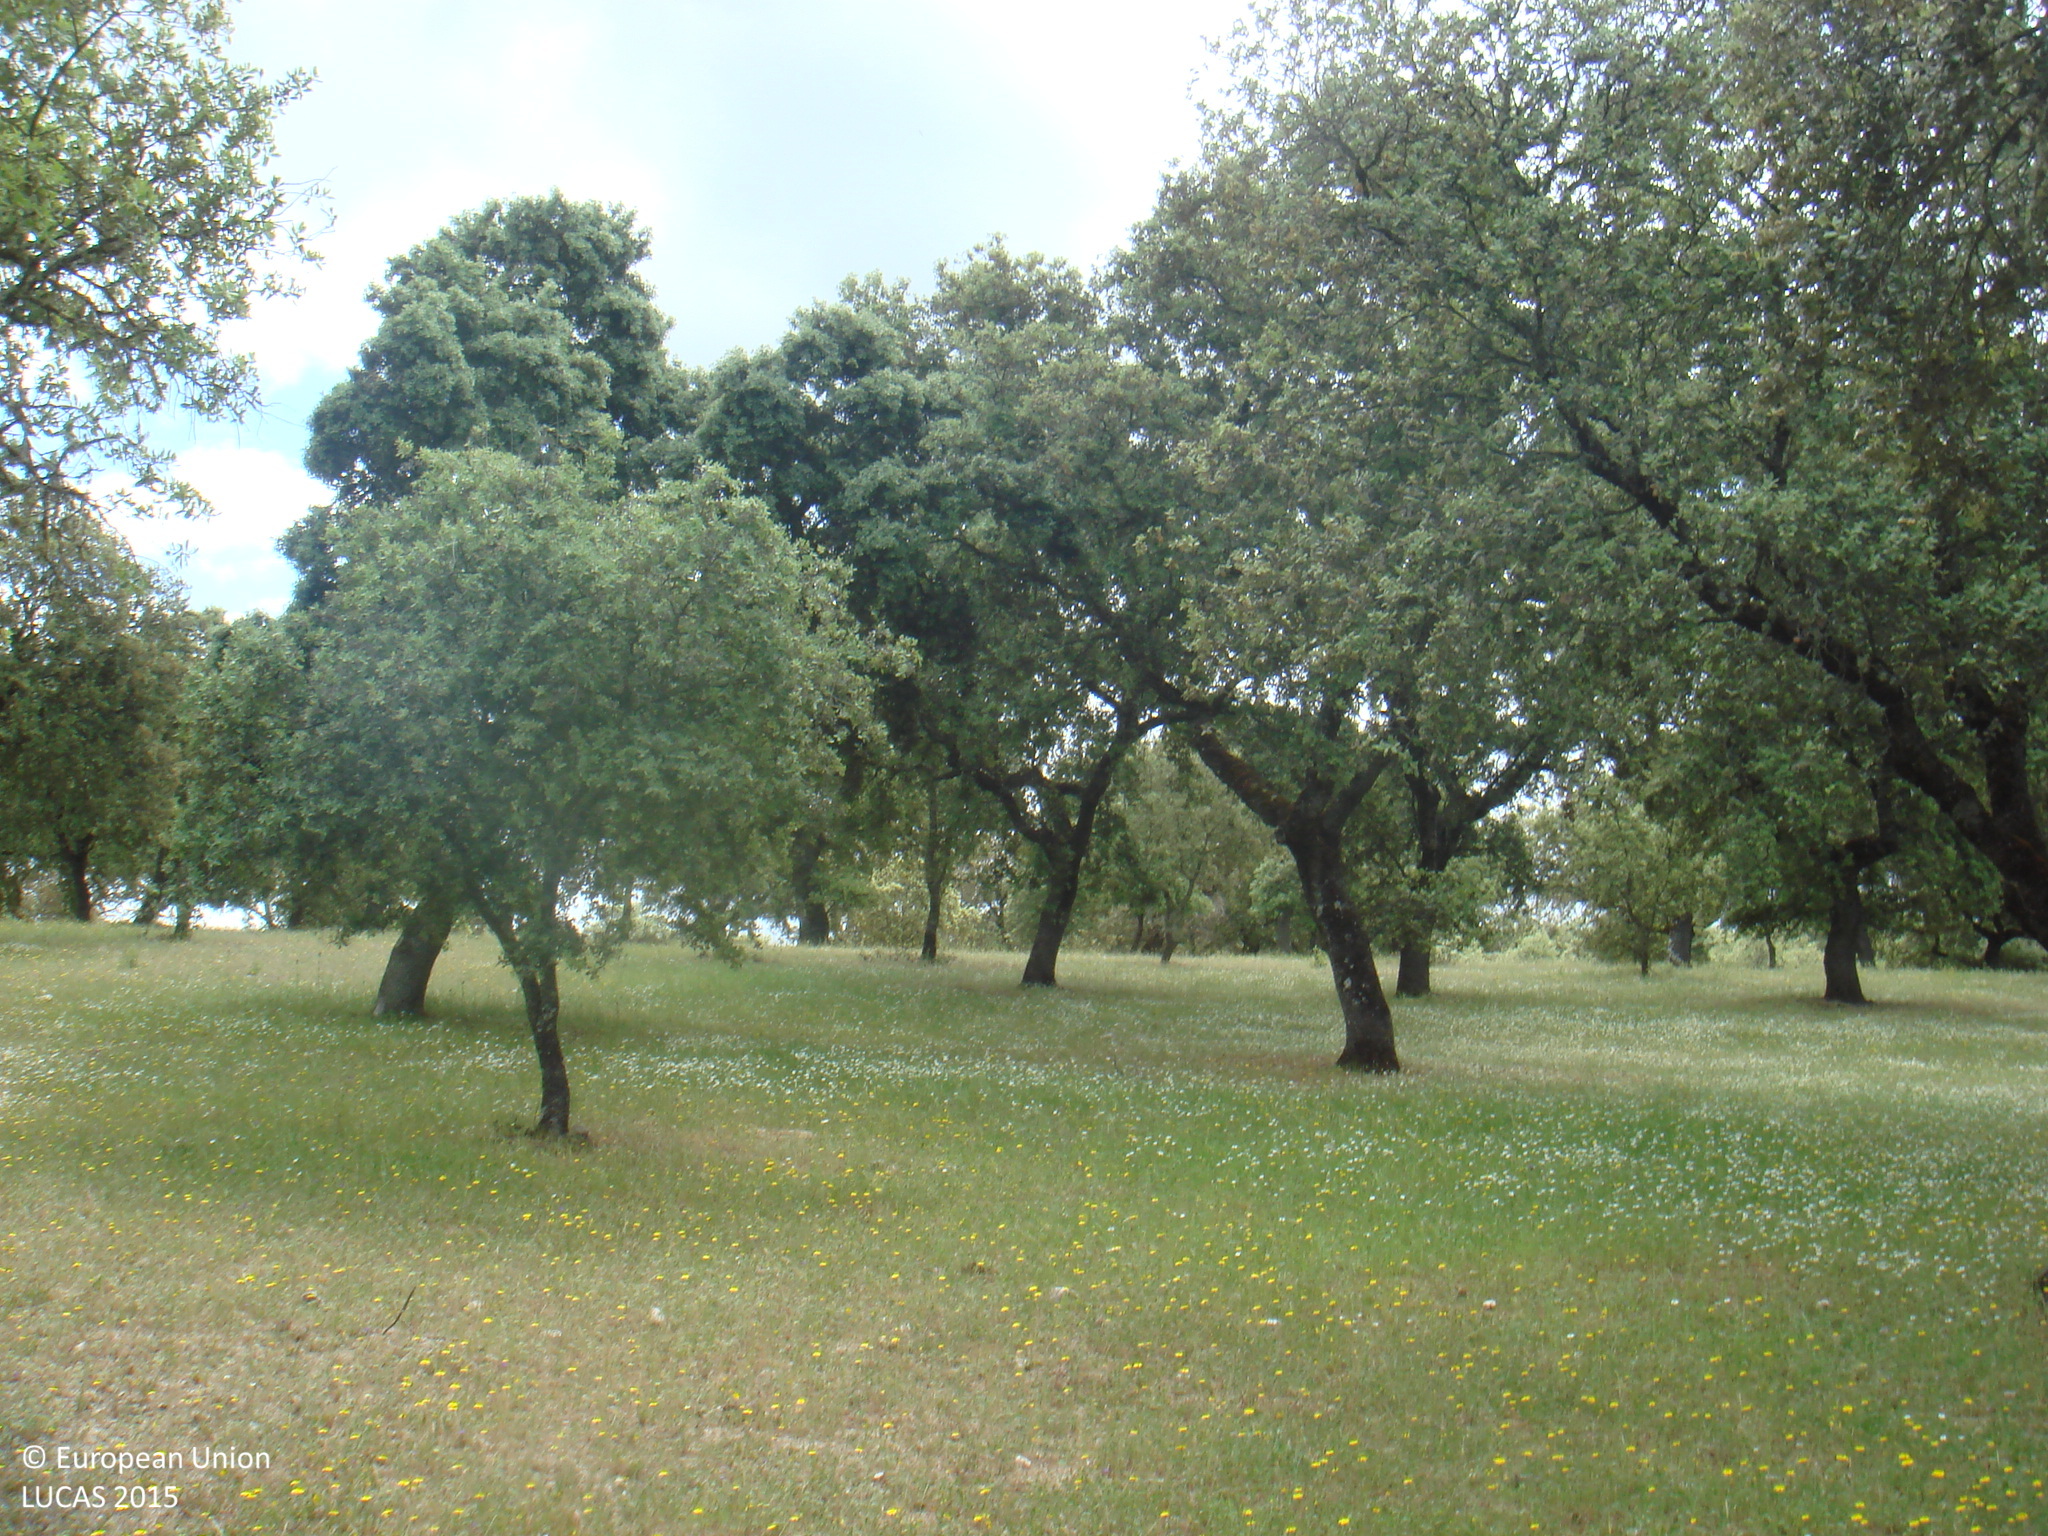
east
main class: Woodland
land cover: Broadleaved woodland
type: broadleaved evergreen forest
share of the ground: 50 - 75 %
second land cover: Spontaneously vegetated surfaces
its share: > 75 %
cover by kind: broadleaved forest trees 60 %, herbaceous plants 40 %
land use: Forestry
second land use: Agriculture (excluding fallow land and kitchen gardens)
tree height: > 5 m
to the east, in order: Broadleaved woodland; Spontaneously vegetated surfaces; Fences; Grass margins; Tracks; Fences; Broadleaved woodland
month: May
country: ES
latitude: 38.3187
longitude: -4.3935
